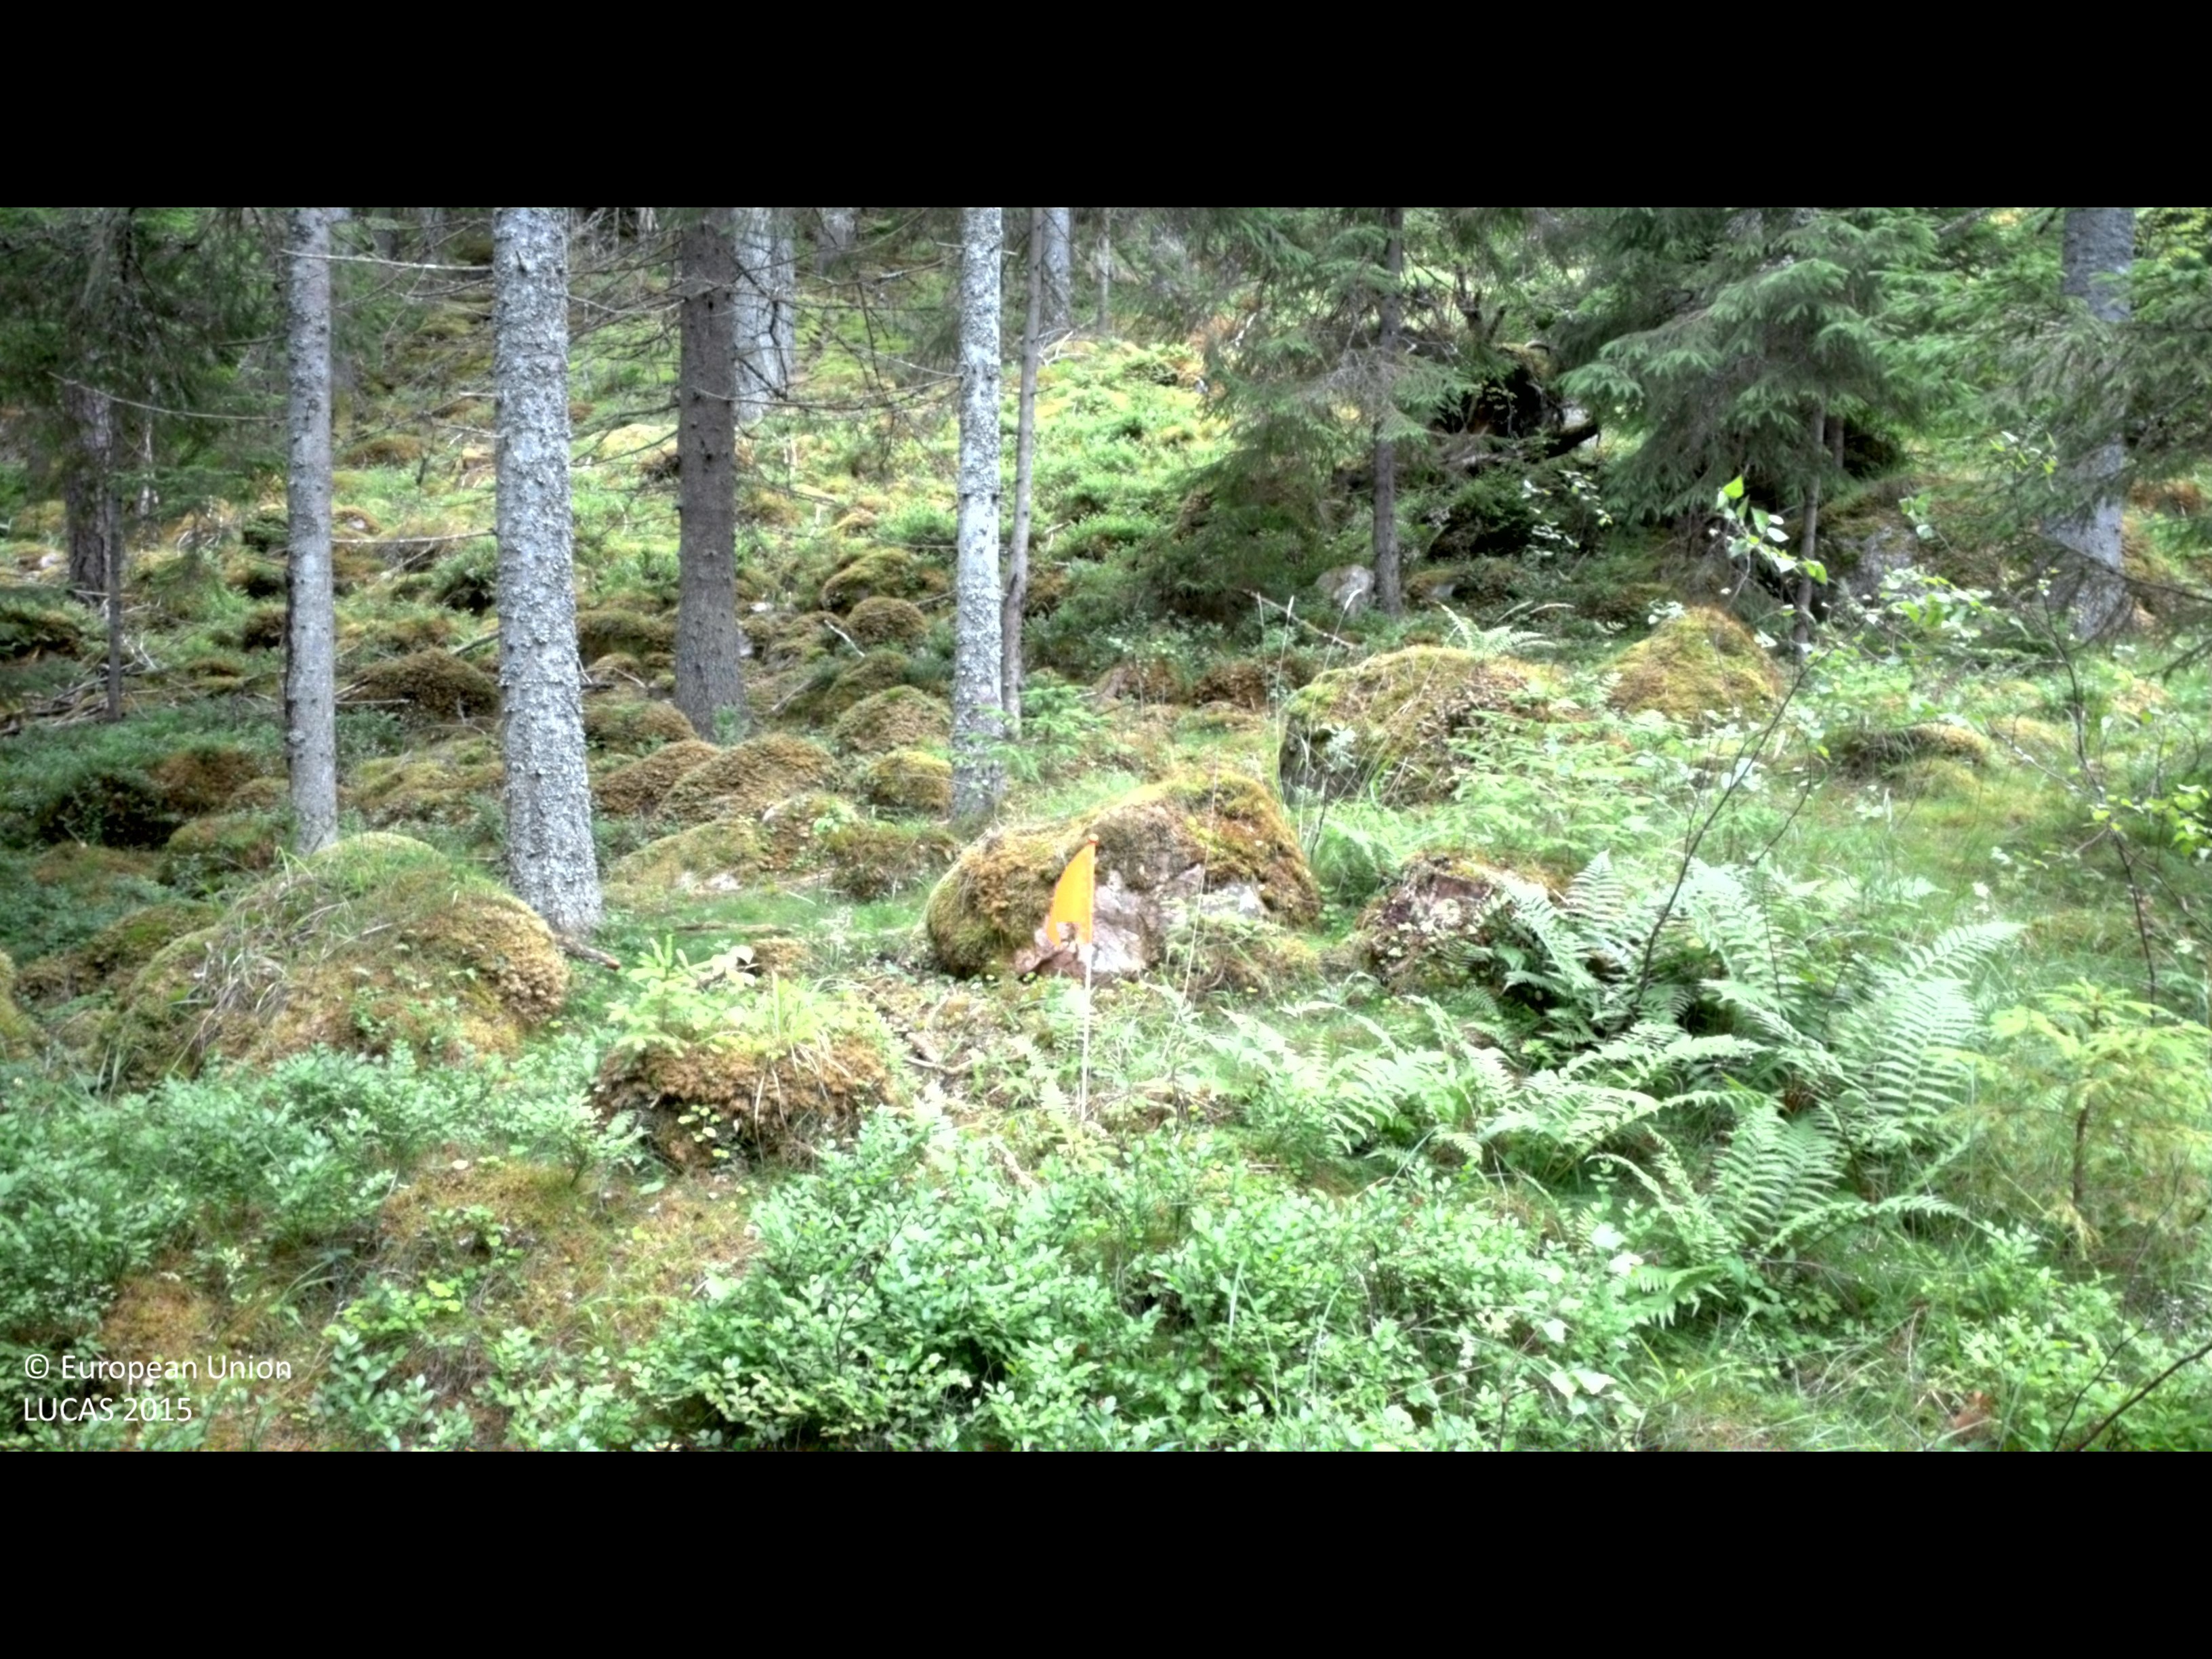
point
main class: Woodland
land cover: Spruce dominated coniferous woodland
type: boreal forest
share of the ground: 50 - 75 %
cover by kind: coniferous forest trees 55 %, shrubs 25 %, herbaceous plants 10 %, broadleaved forest trees 5 %, lichens and mosses 5 %
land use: Forestry
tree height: > 5 m
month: July
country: SE
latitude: 58.1277
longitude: 16.2622
